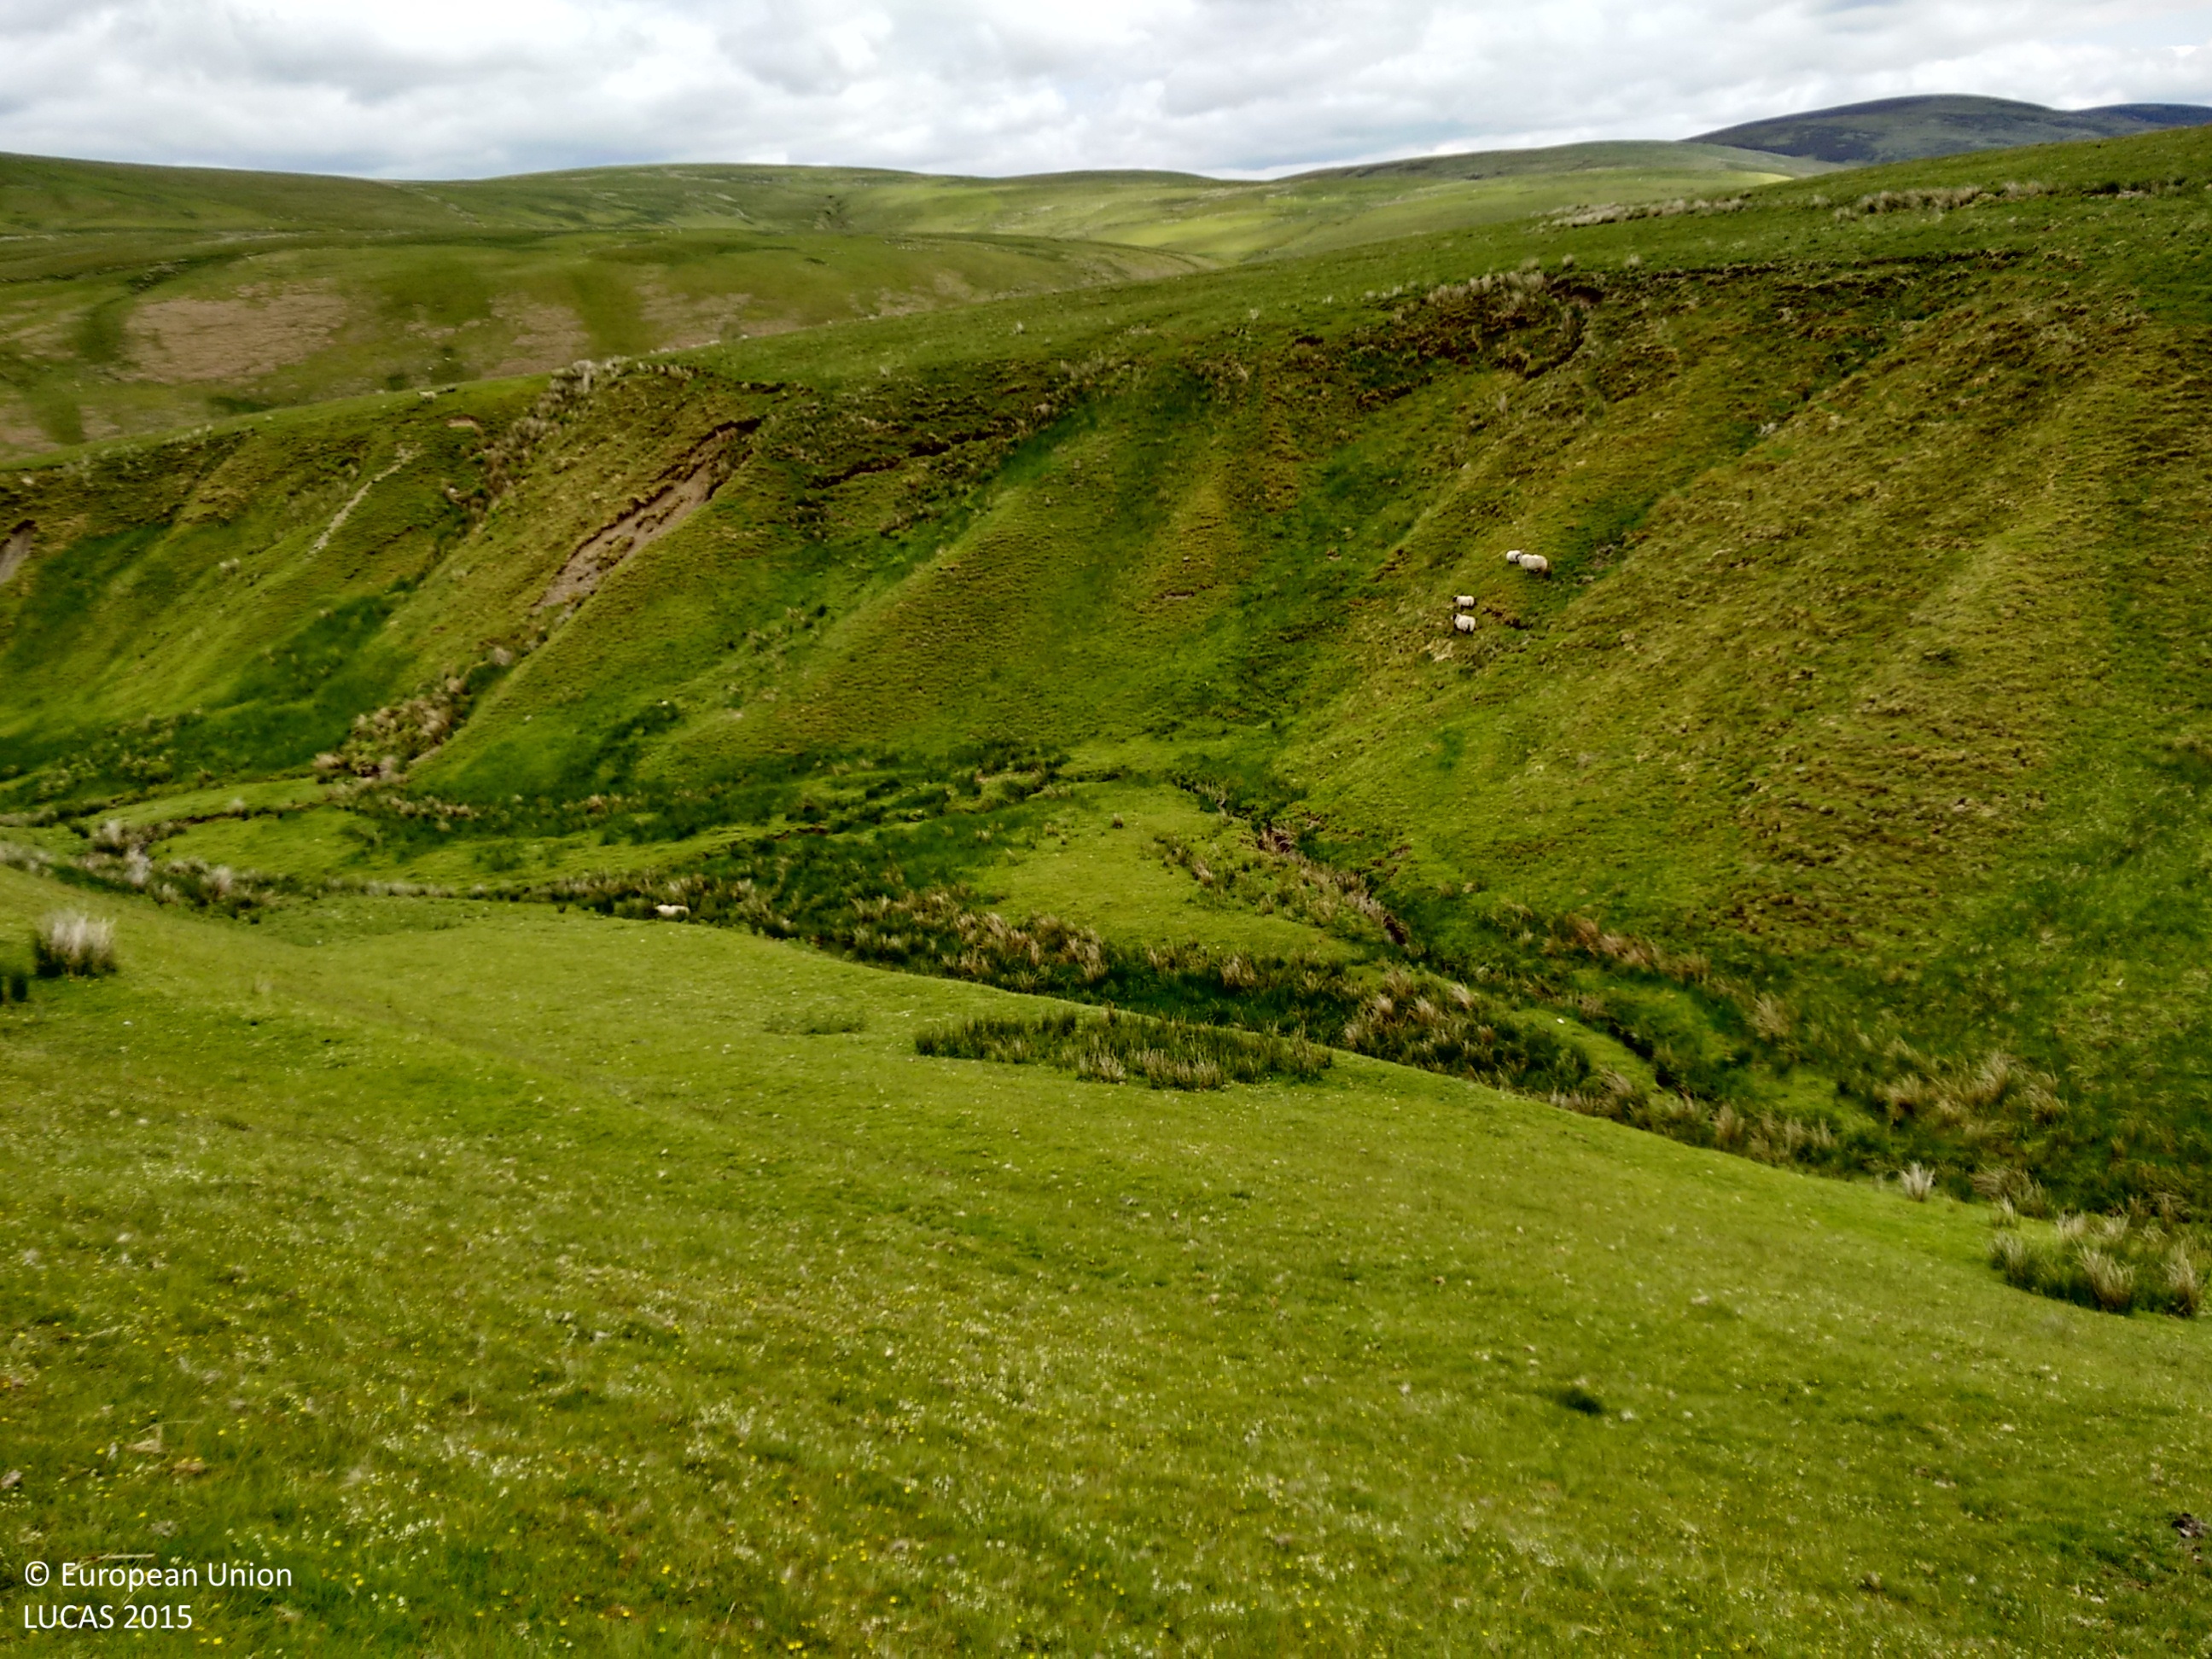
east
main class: Grassland
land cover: Grassland without tree/shrub cover
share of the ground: > 75 %
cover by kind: herbaceous plants 100 %
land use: Agriculture (excluding fallow land and kitchen gardens)
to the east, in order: Grassland without tree/shrub cover; Rivers and streams; Grassland without tree/shrub cover; Tracks; Grassland without tree/shrub cover; Shrubland without tree cover; Grassland without tree/shrub cover
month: June
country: GB
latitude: 55.4316
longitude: -3.8510
